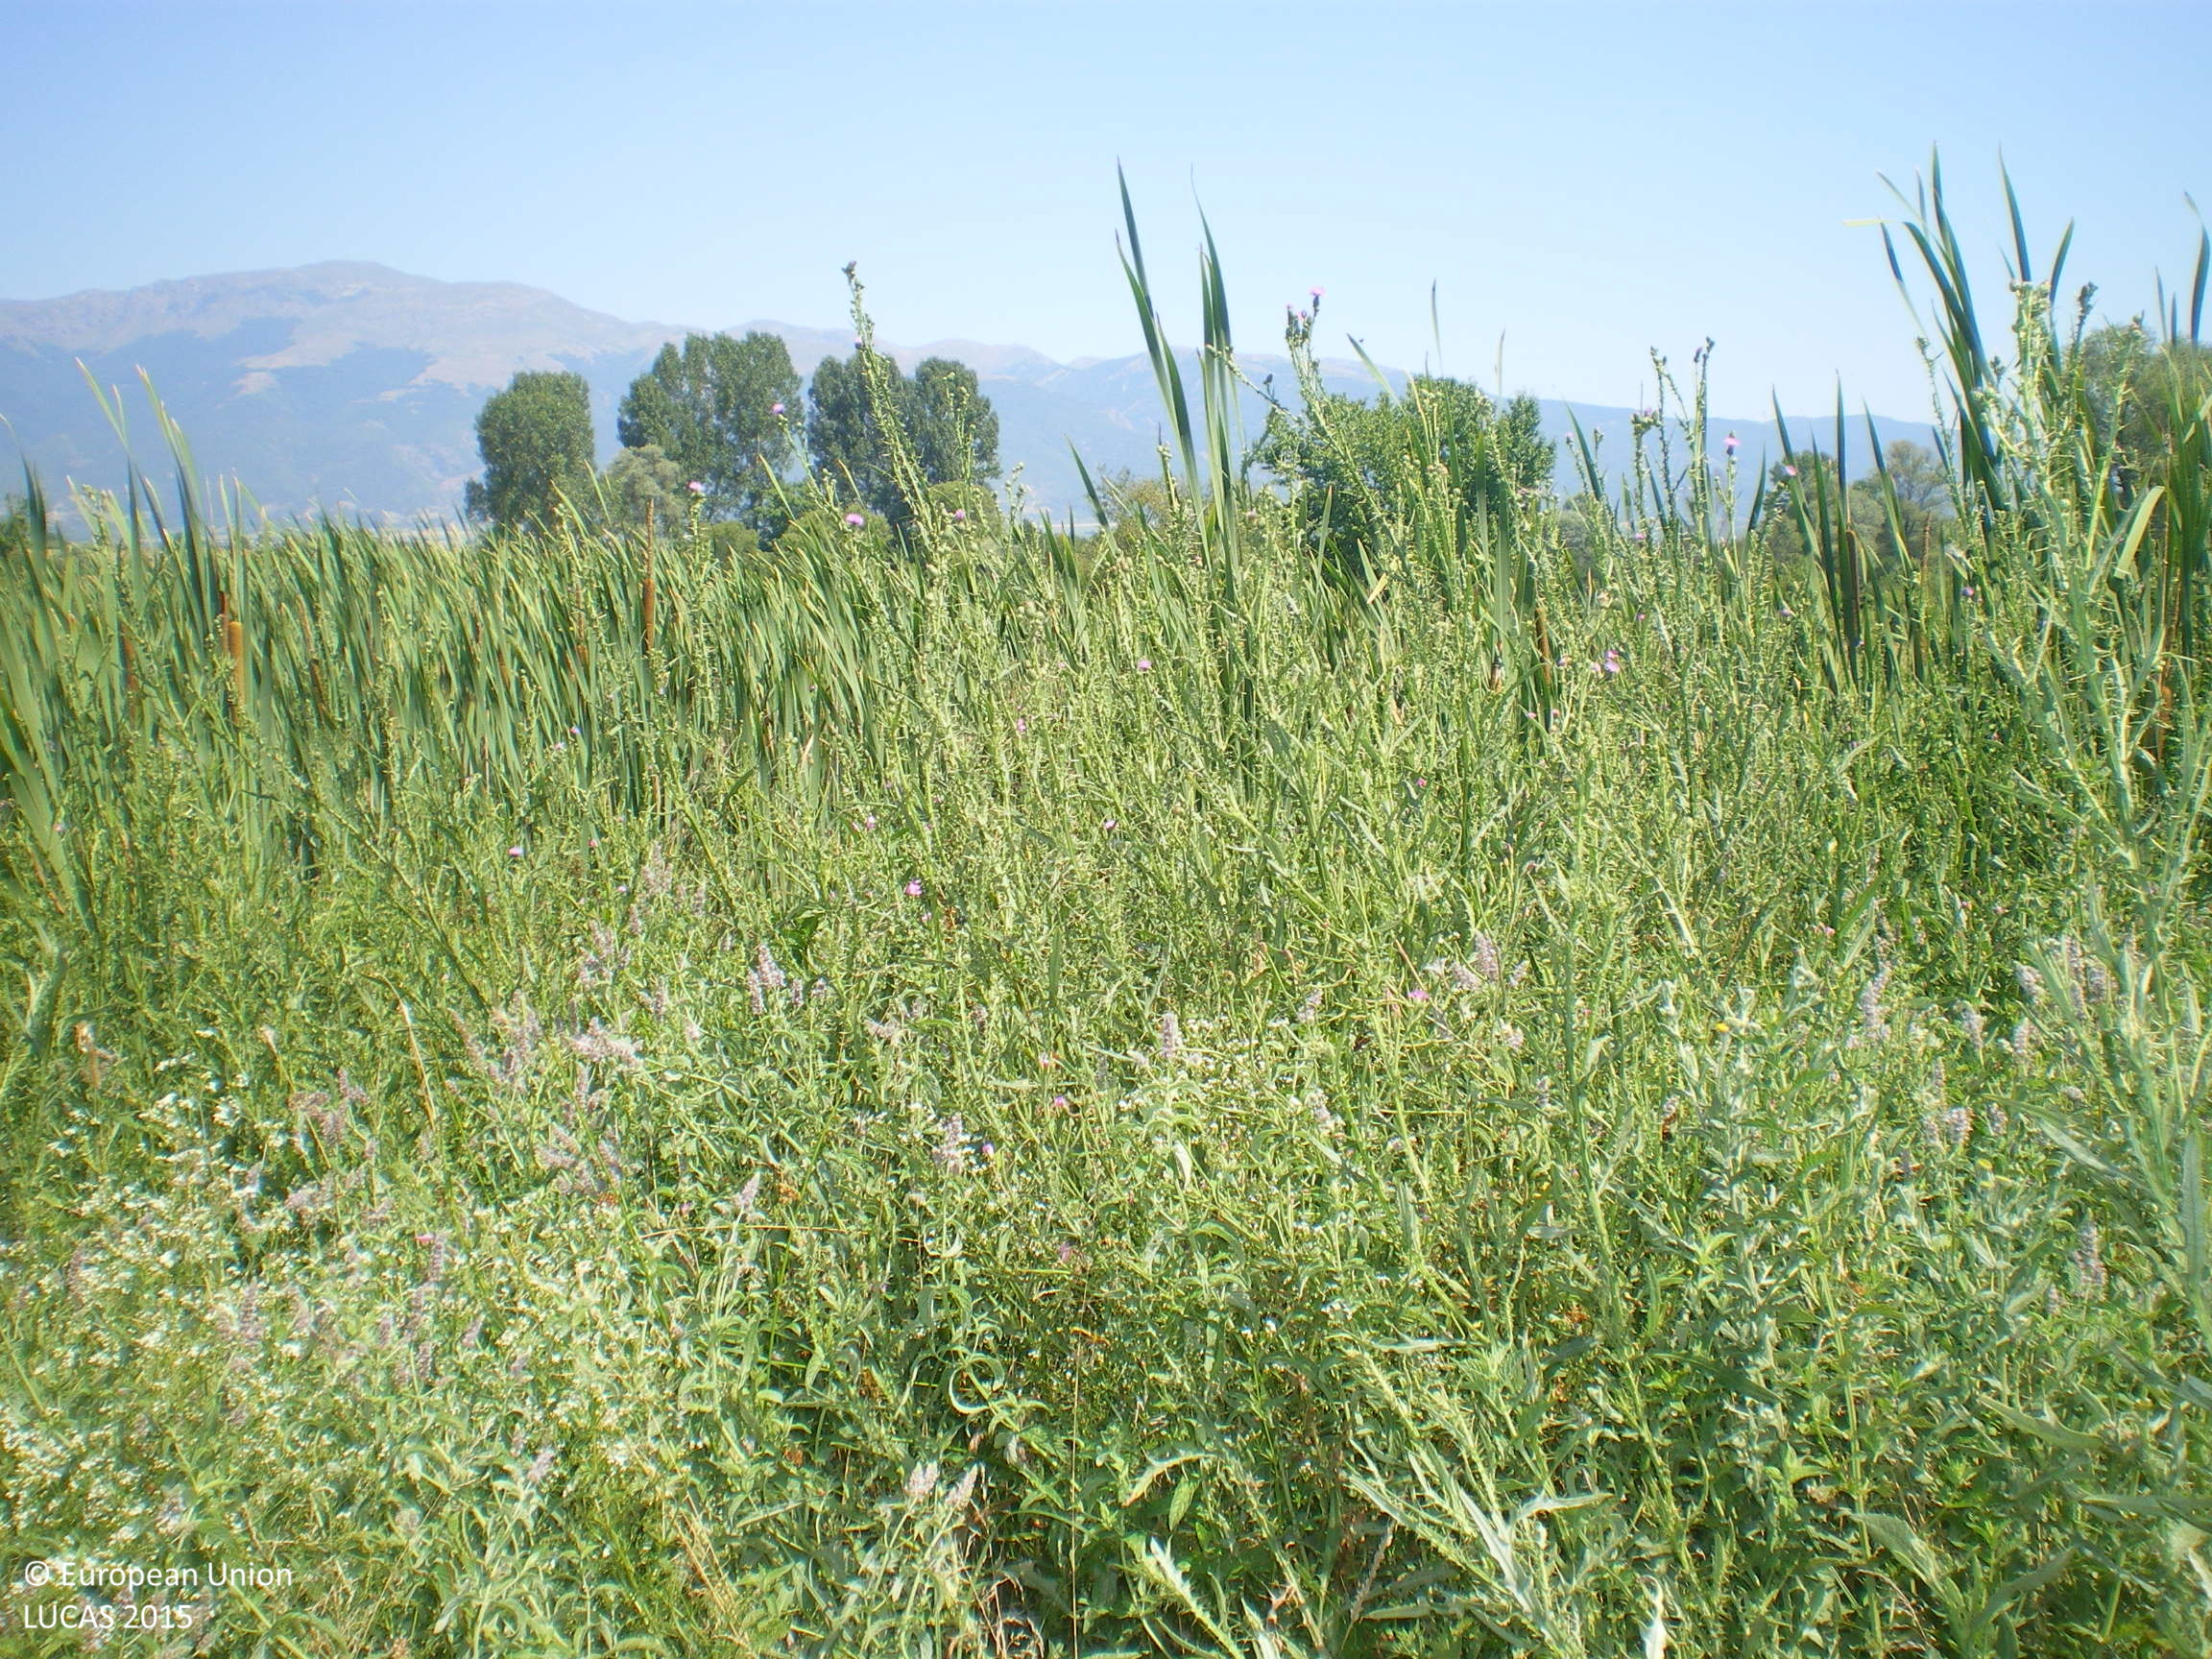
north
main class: Grassland
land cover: Spontaneously vegetated surfaces
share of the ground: > 75 %
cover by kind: herbaceous plants 100 %
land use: Semi-natural and natural areas not in use
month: July
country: BG
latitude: 42.5943
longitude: 25.1143
